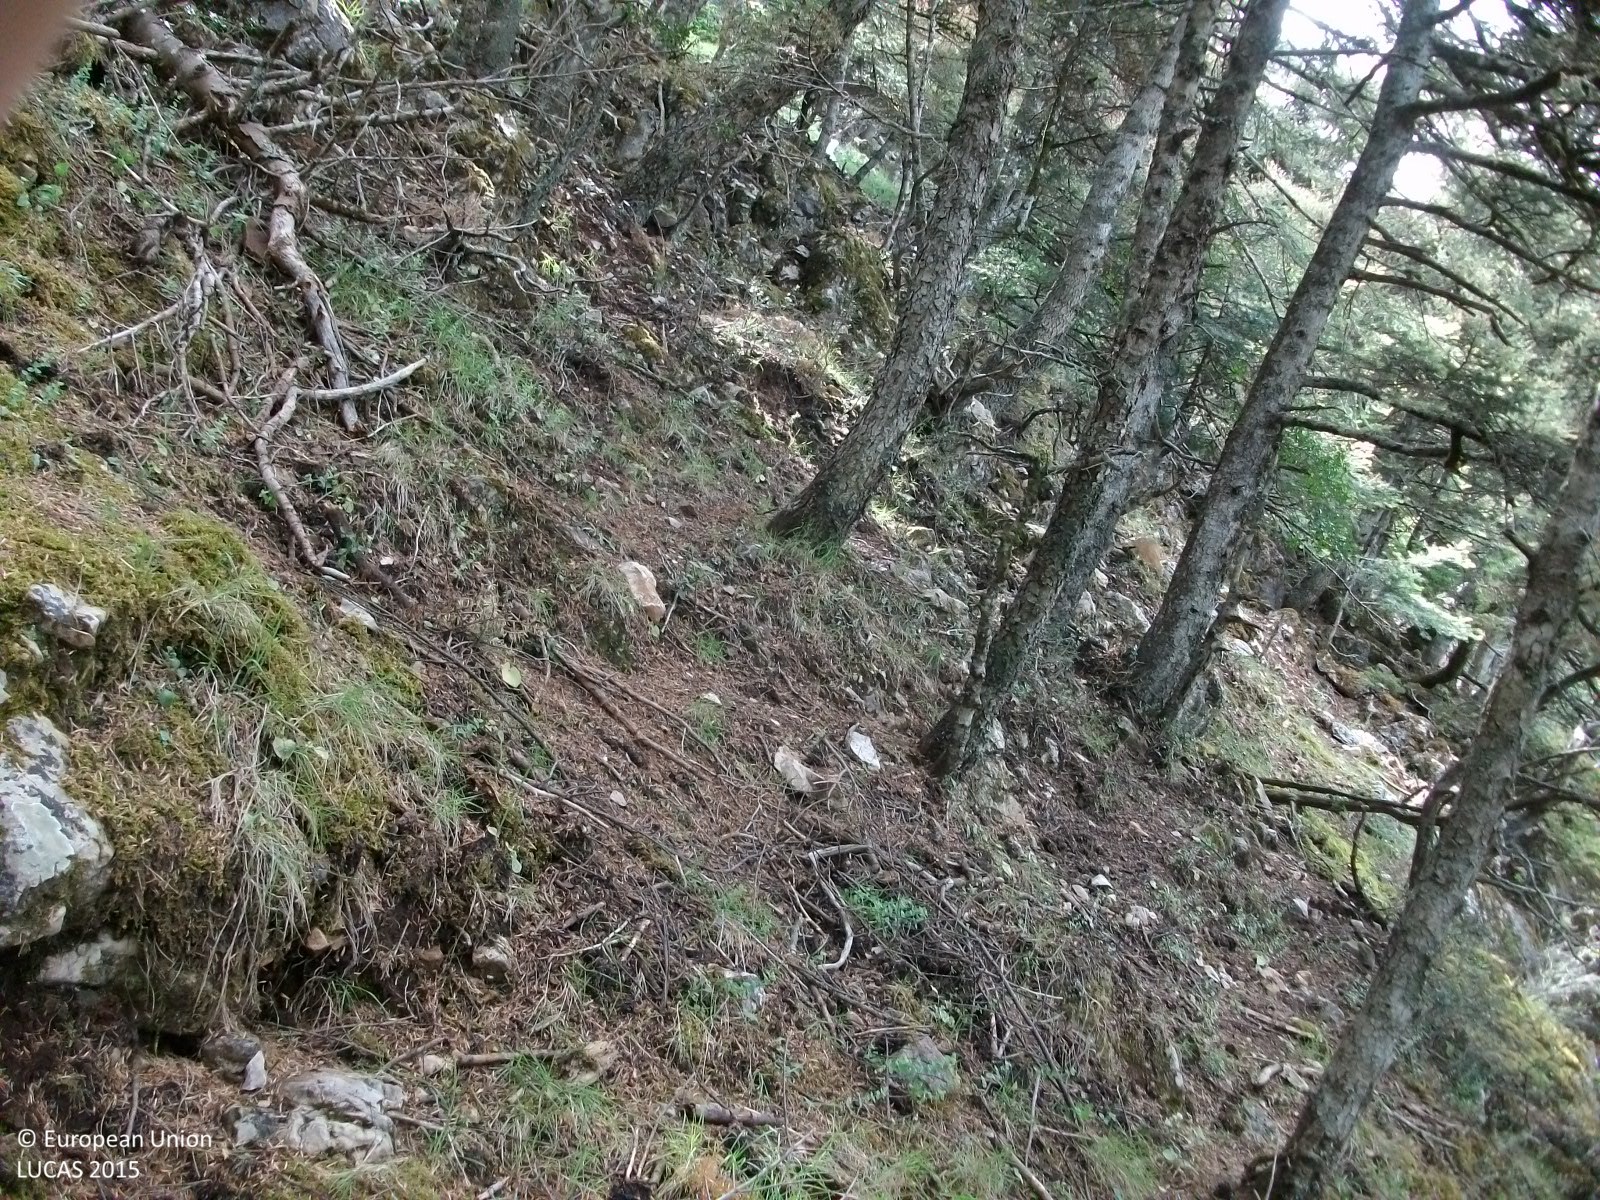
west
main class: Woodland
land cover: Spruce dominated coniferous woodland
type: coniferous forest of the mediterranean region
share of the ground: > 75 %
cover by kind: coniferous forest trees 100 %
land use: Forestry
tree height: > 5 m
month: June
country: GR
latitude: 36.8424
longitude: 22.3885
